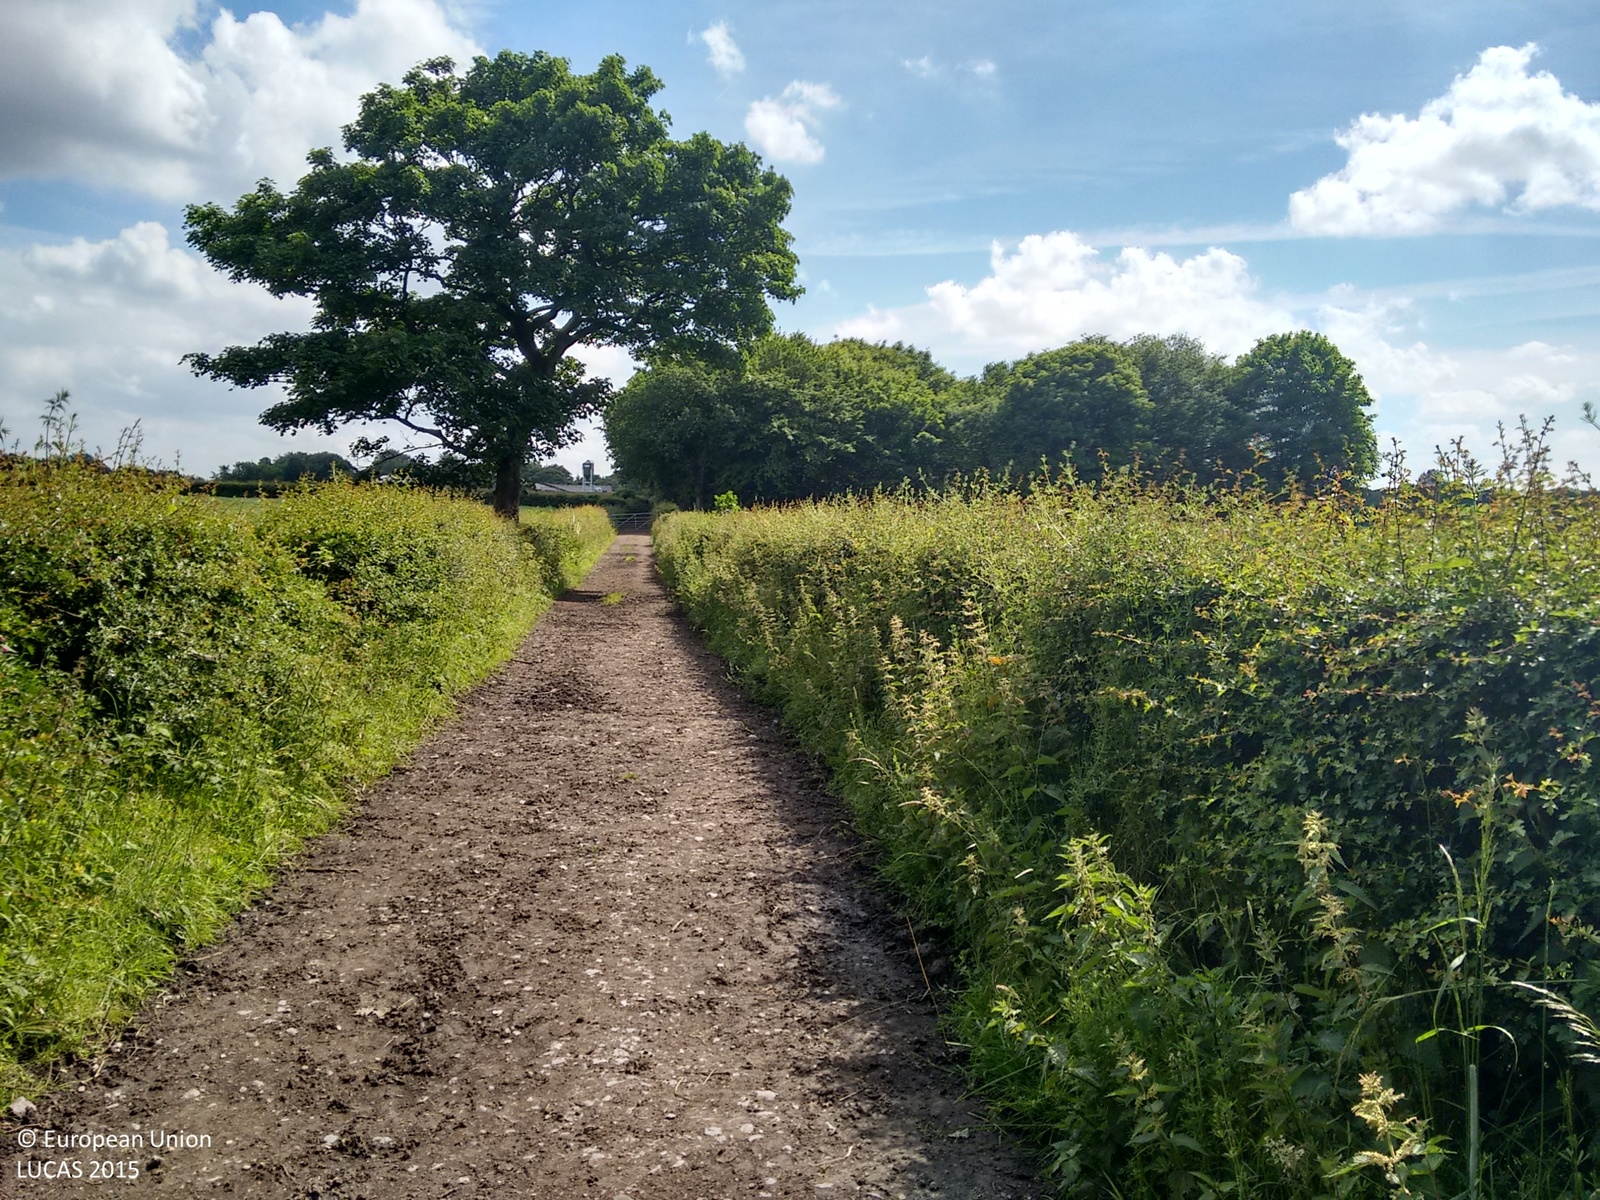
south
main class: Grassland
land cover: Grassland without tree/shrub cover
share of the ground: > 75 %
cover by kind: herbaceous plants 100 %
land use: Agriculture (excluding fallow land and kitchen gardens)
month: June
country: GB
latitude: 53.5533
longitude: -2.4879
